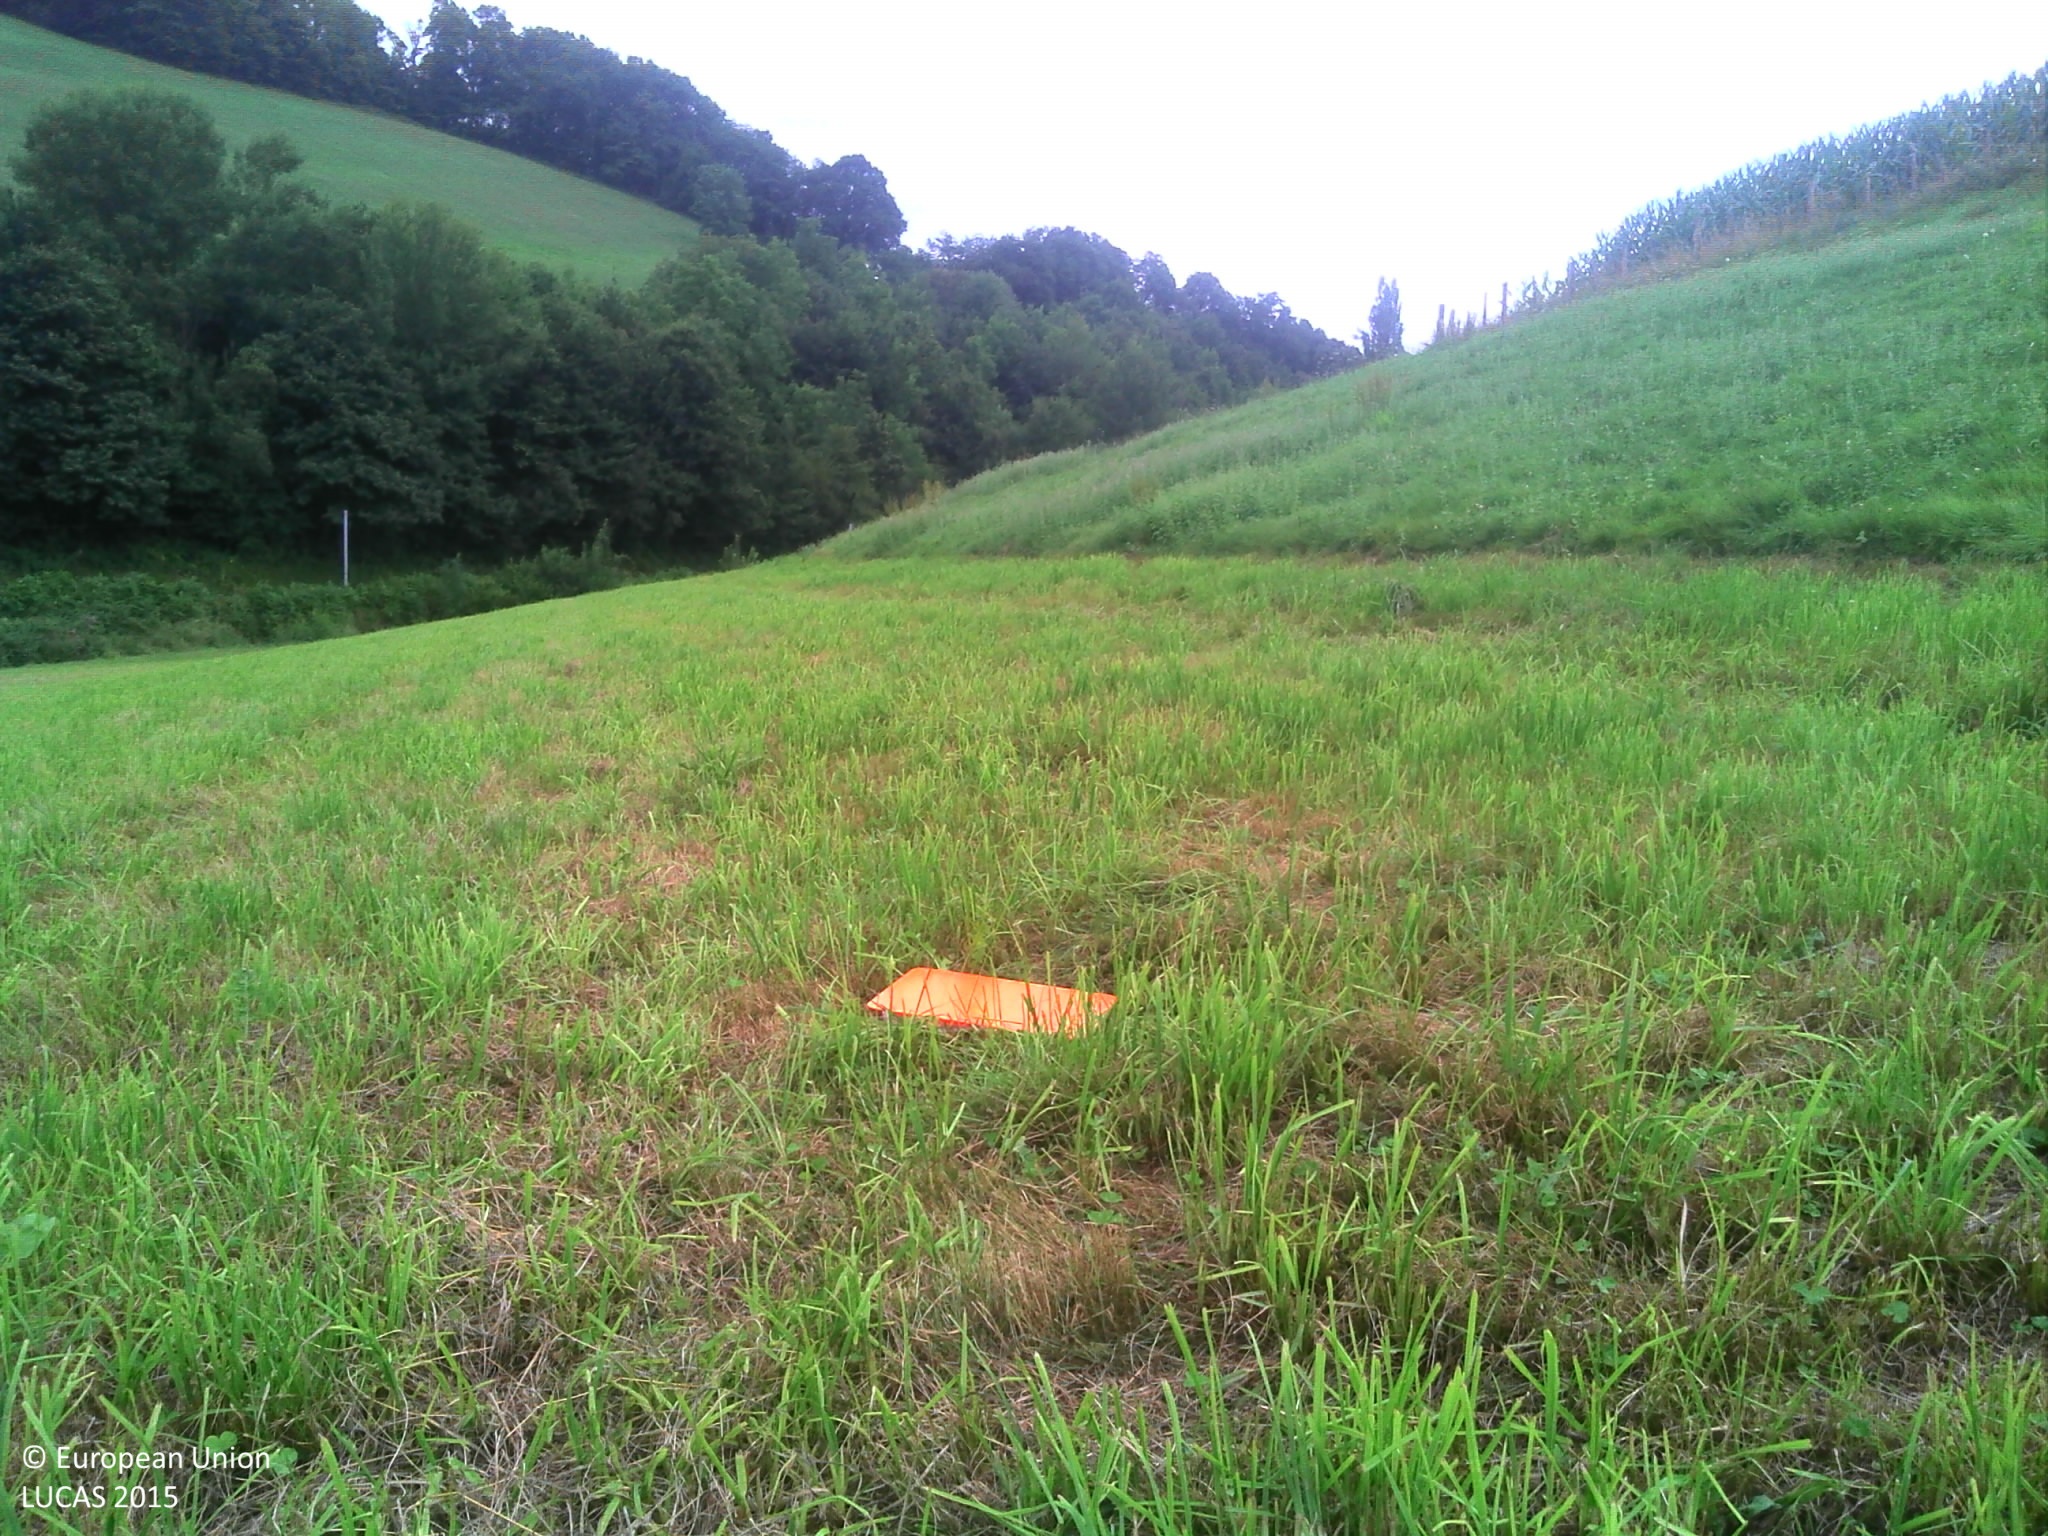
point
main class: Grassland
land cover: Grassland without tree/shrub cover
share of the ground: > 75 %
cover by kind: herbaceous plants 100 %
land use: Agriculture (excluding fallow land and kitchen gardens)
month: August
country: FR
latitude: 43.2347
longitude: -1.1819
